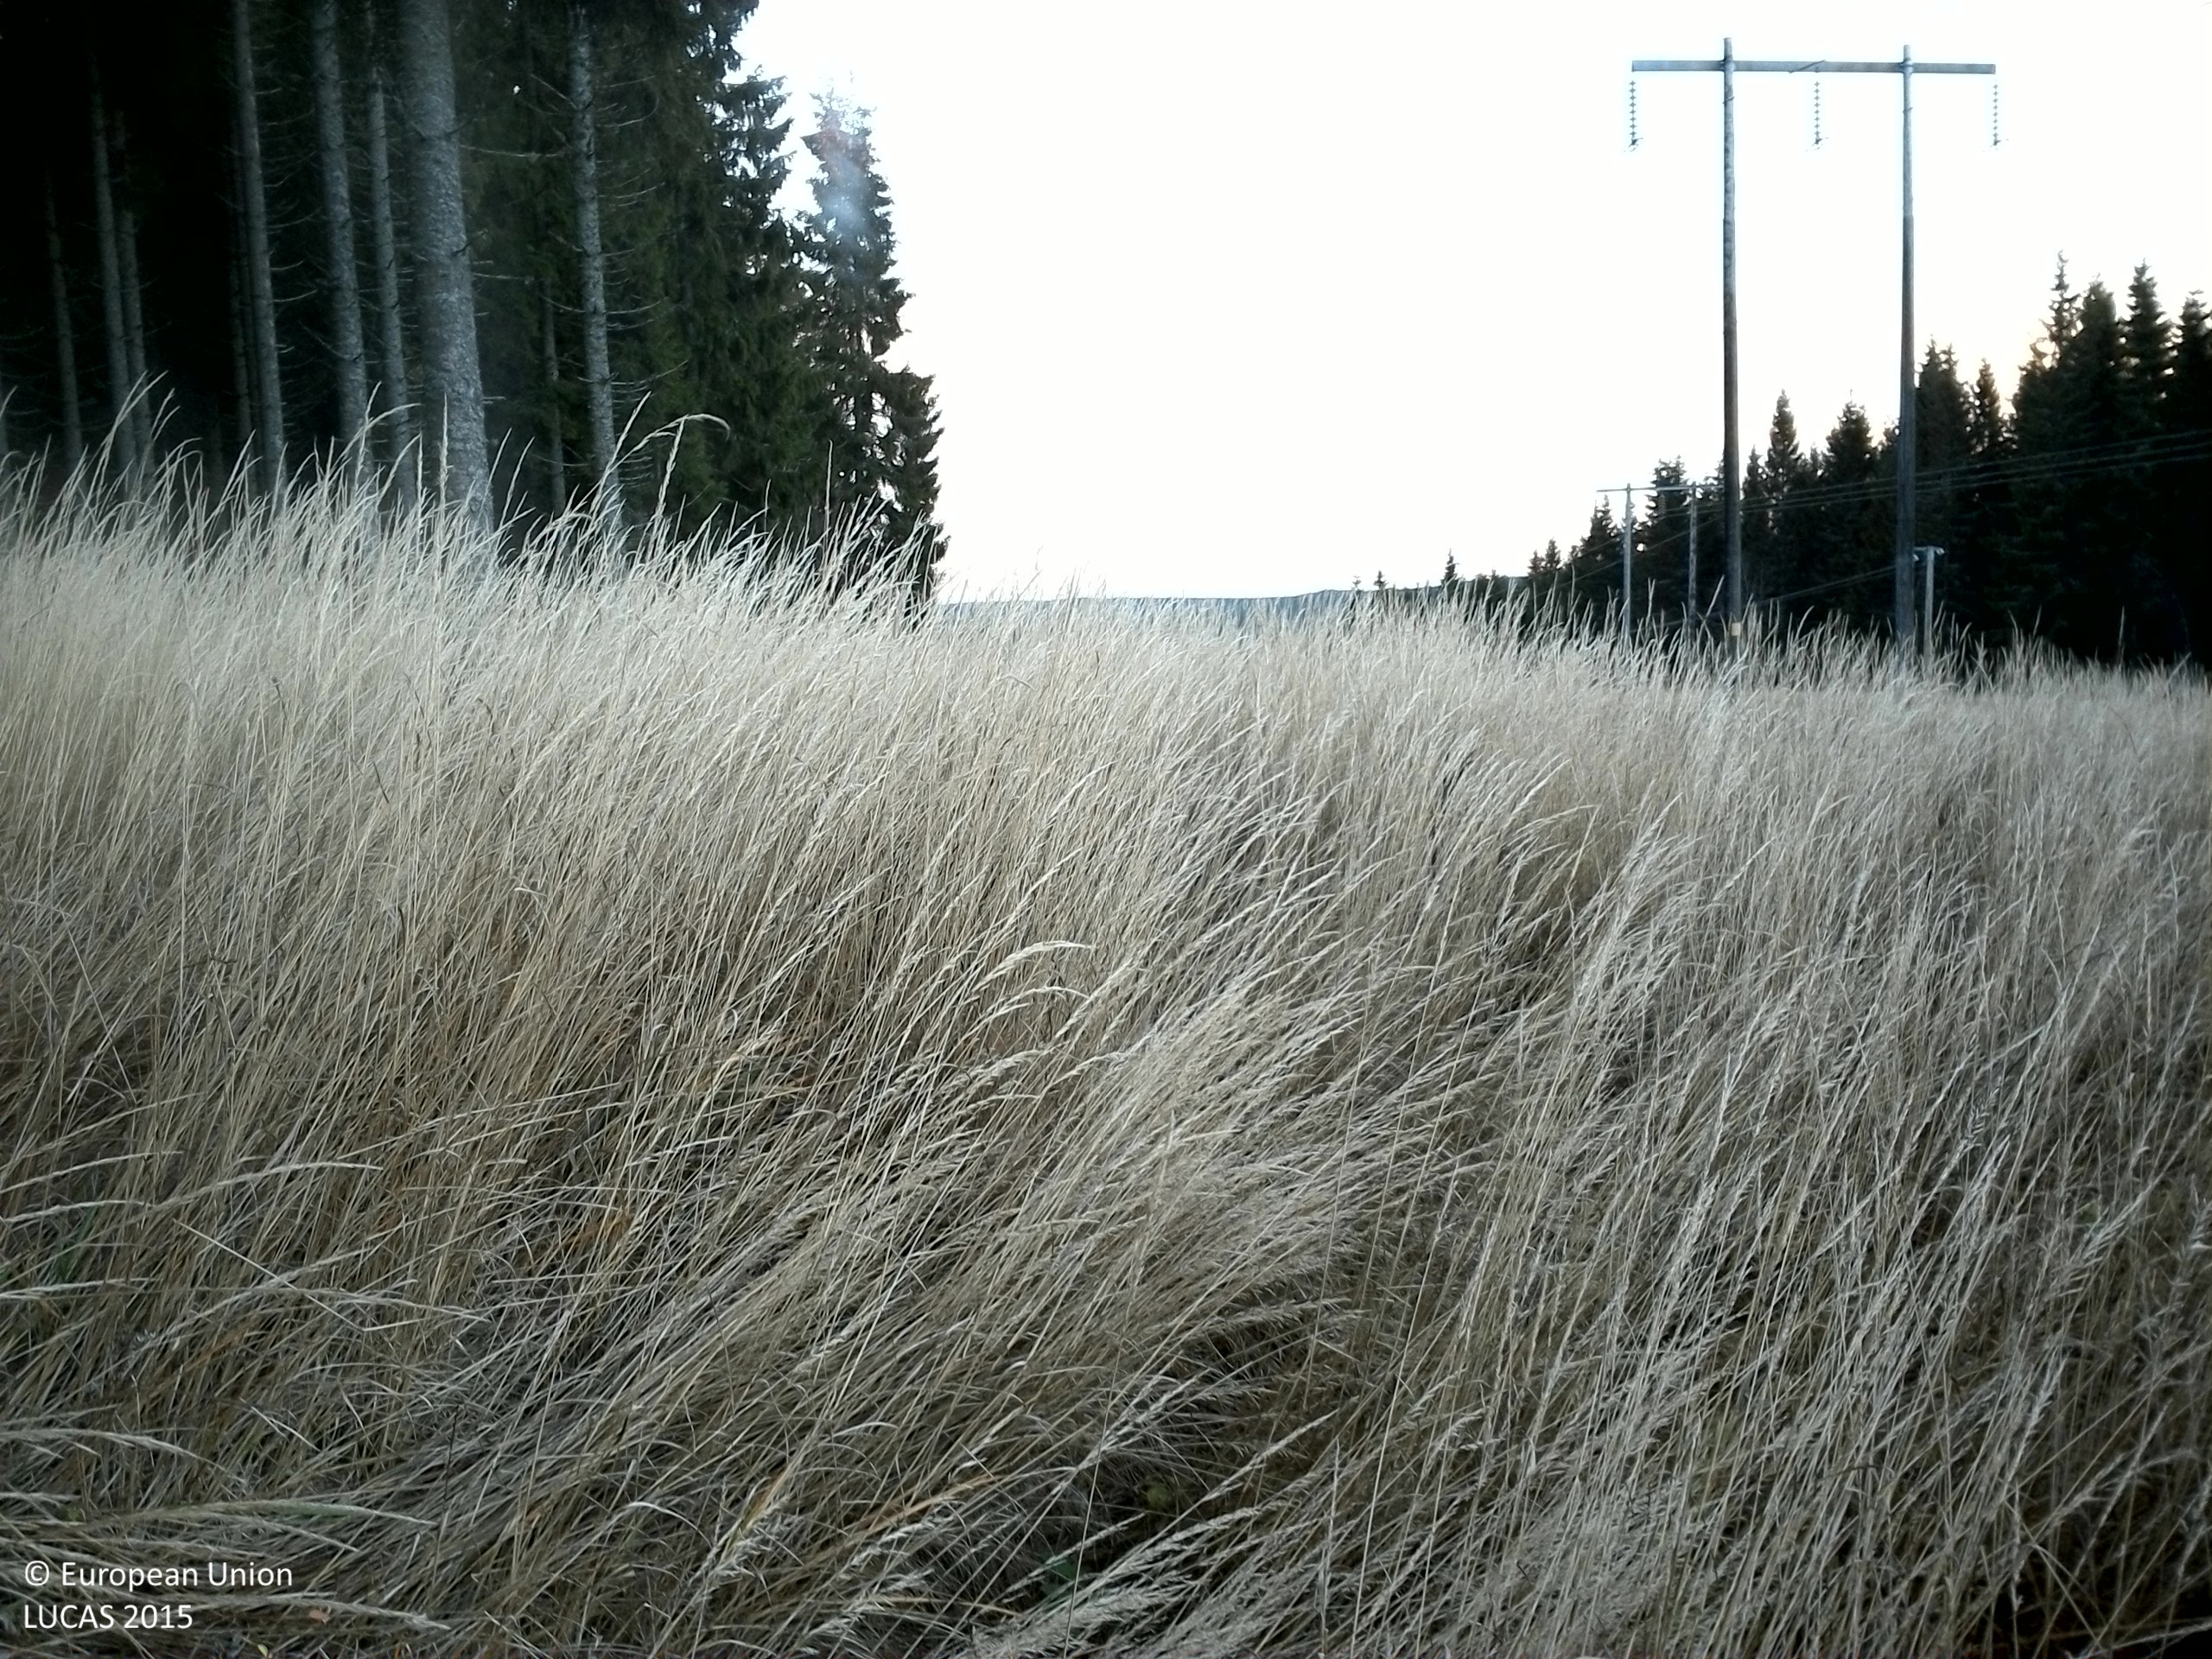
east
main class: Grassland
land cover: Grassland with sparse tree/shrub cover
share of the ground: > 75 %
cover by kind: herbaceous plants 95 %, coniferous forest trees 5 %
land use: Electricity, gas and thermal power distribution
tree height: < 5 m
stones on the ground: < 10 %
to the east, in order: Grassland with sparse tree/shrub cover; Spruce dominated coniferous woodland
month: November
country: SE
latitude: 60.0521
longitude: 15.1074
